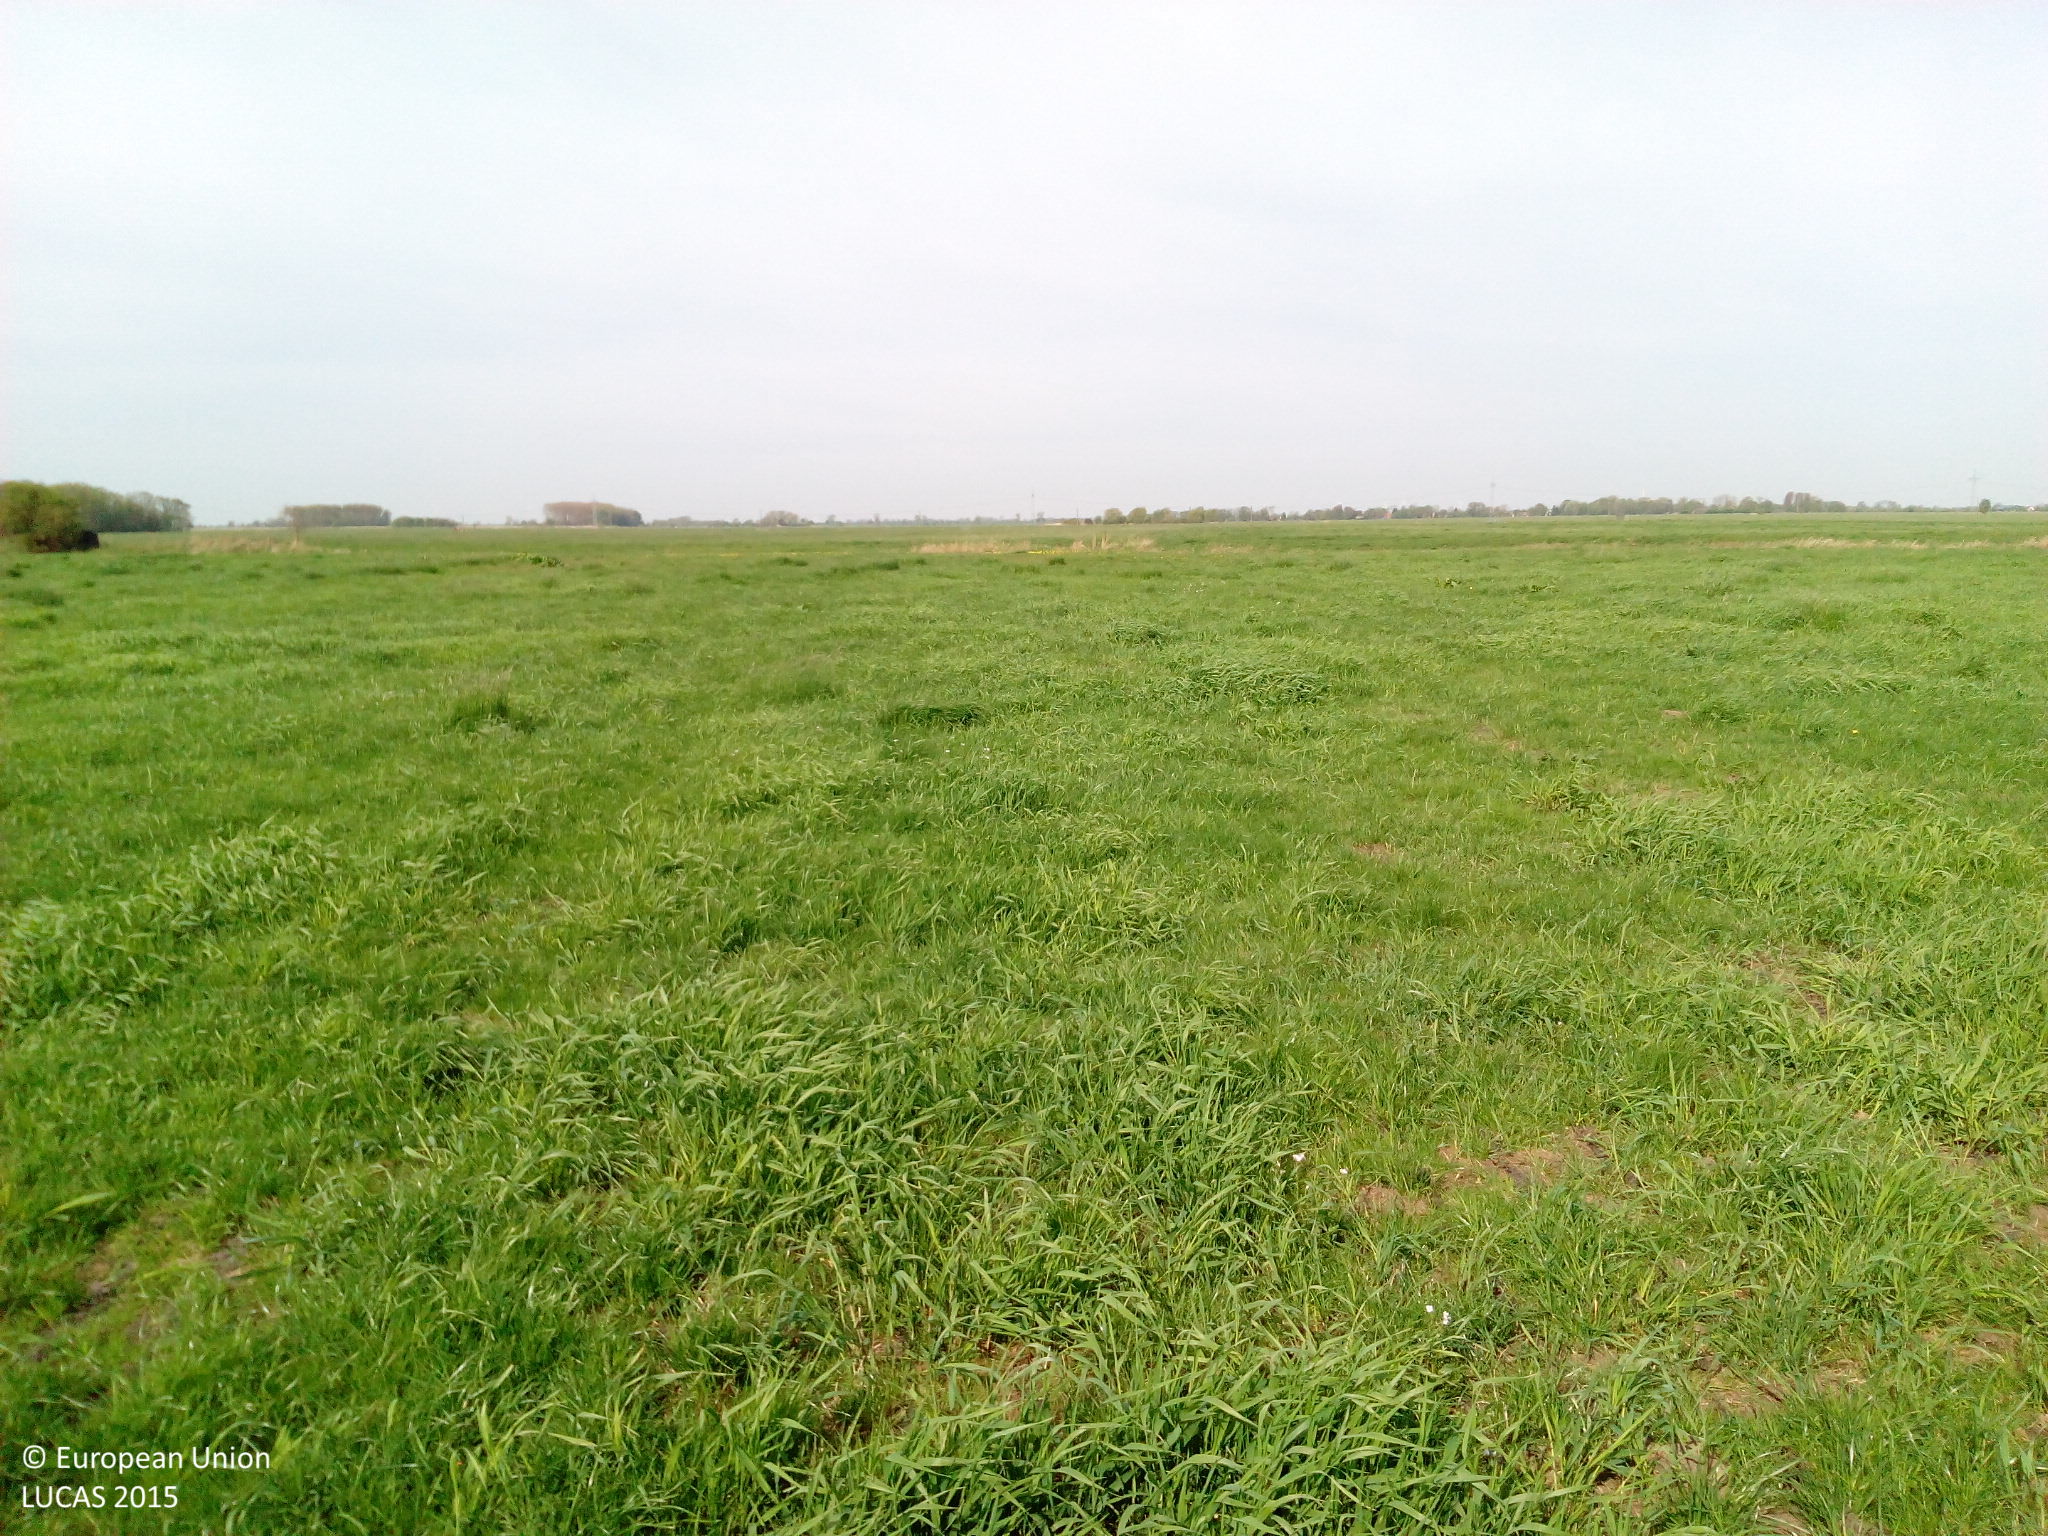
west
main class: Grassland
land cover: Grassland without tree/shrub cover
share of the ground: > 75 %
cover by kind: herbaceous plants 100 %
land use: Agriculture (excluding fallow land and kitchen gardens)
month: May
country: DE
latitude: 53.4115
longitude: 8.5714
